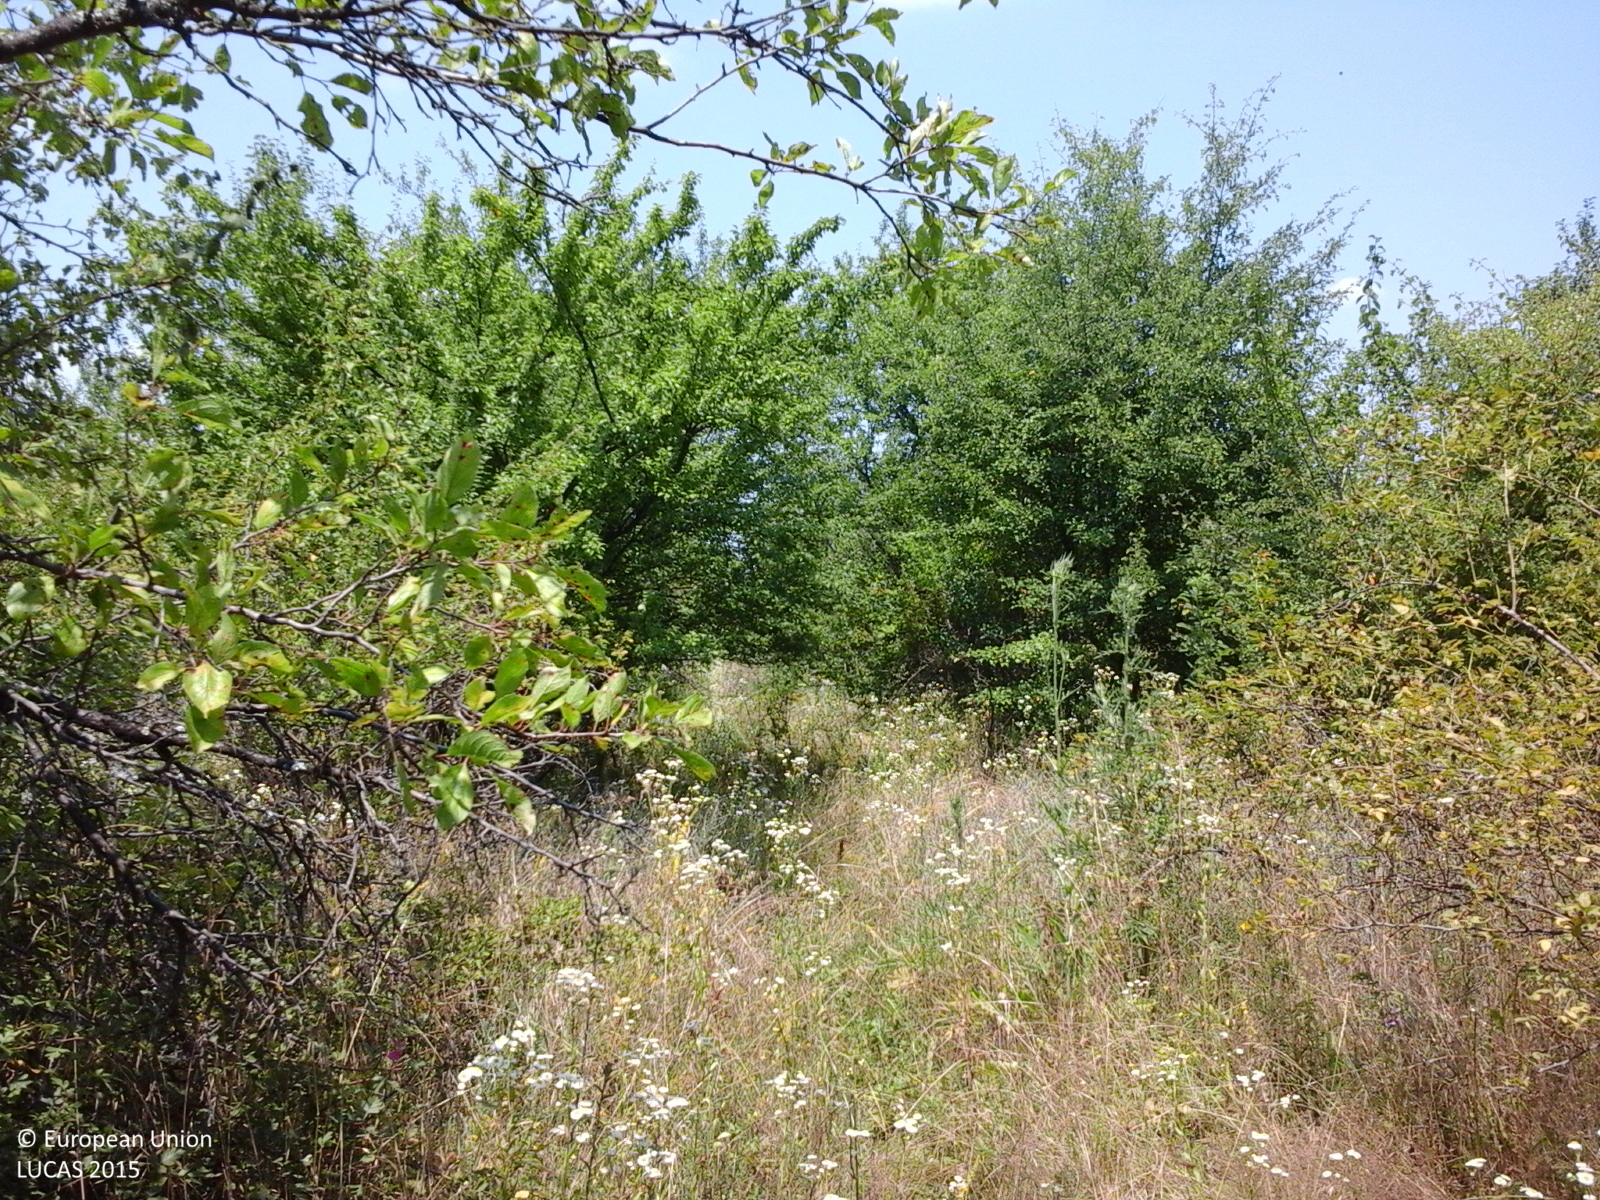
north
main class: Cropland
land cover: Other fruit trees and berries
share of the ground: > 75 %
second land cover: Shrubland without tree cover
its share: 50 - 75 %
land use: Abandoned areas
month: July
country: RO
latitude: 44.7515
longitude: 24.5112
